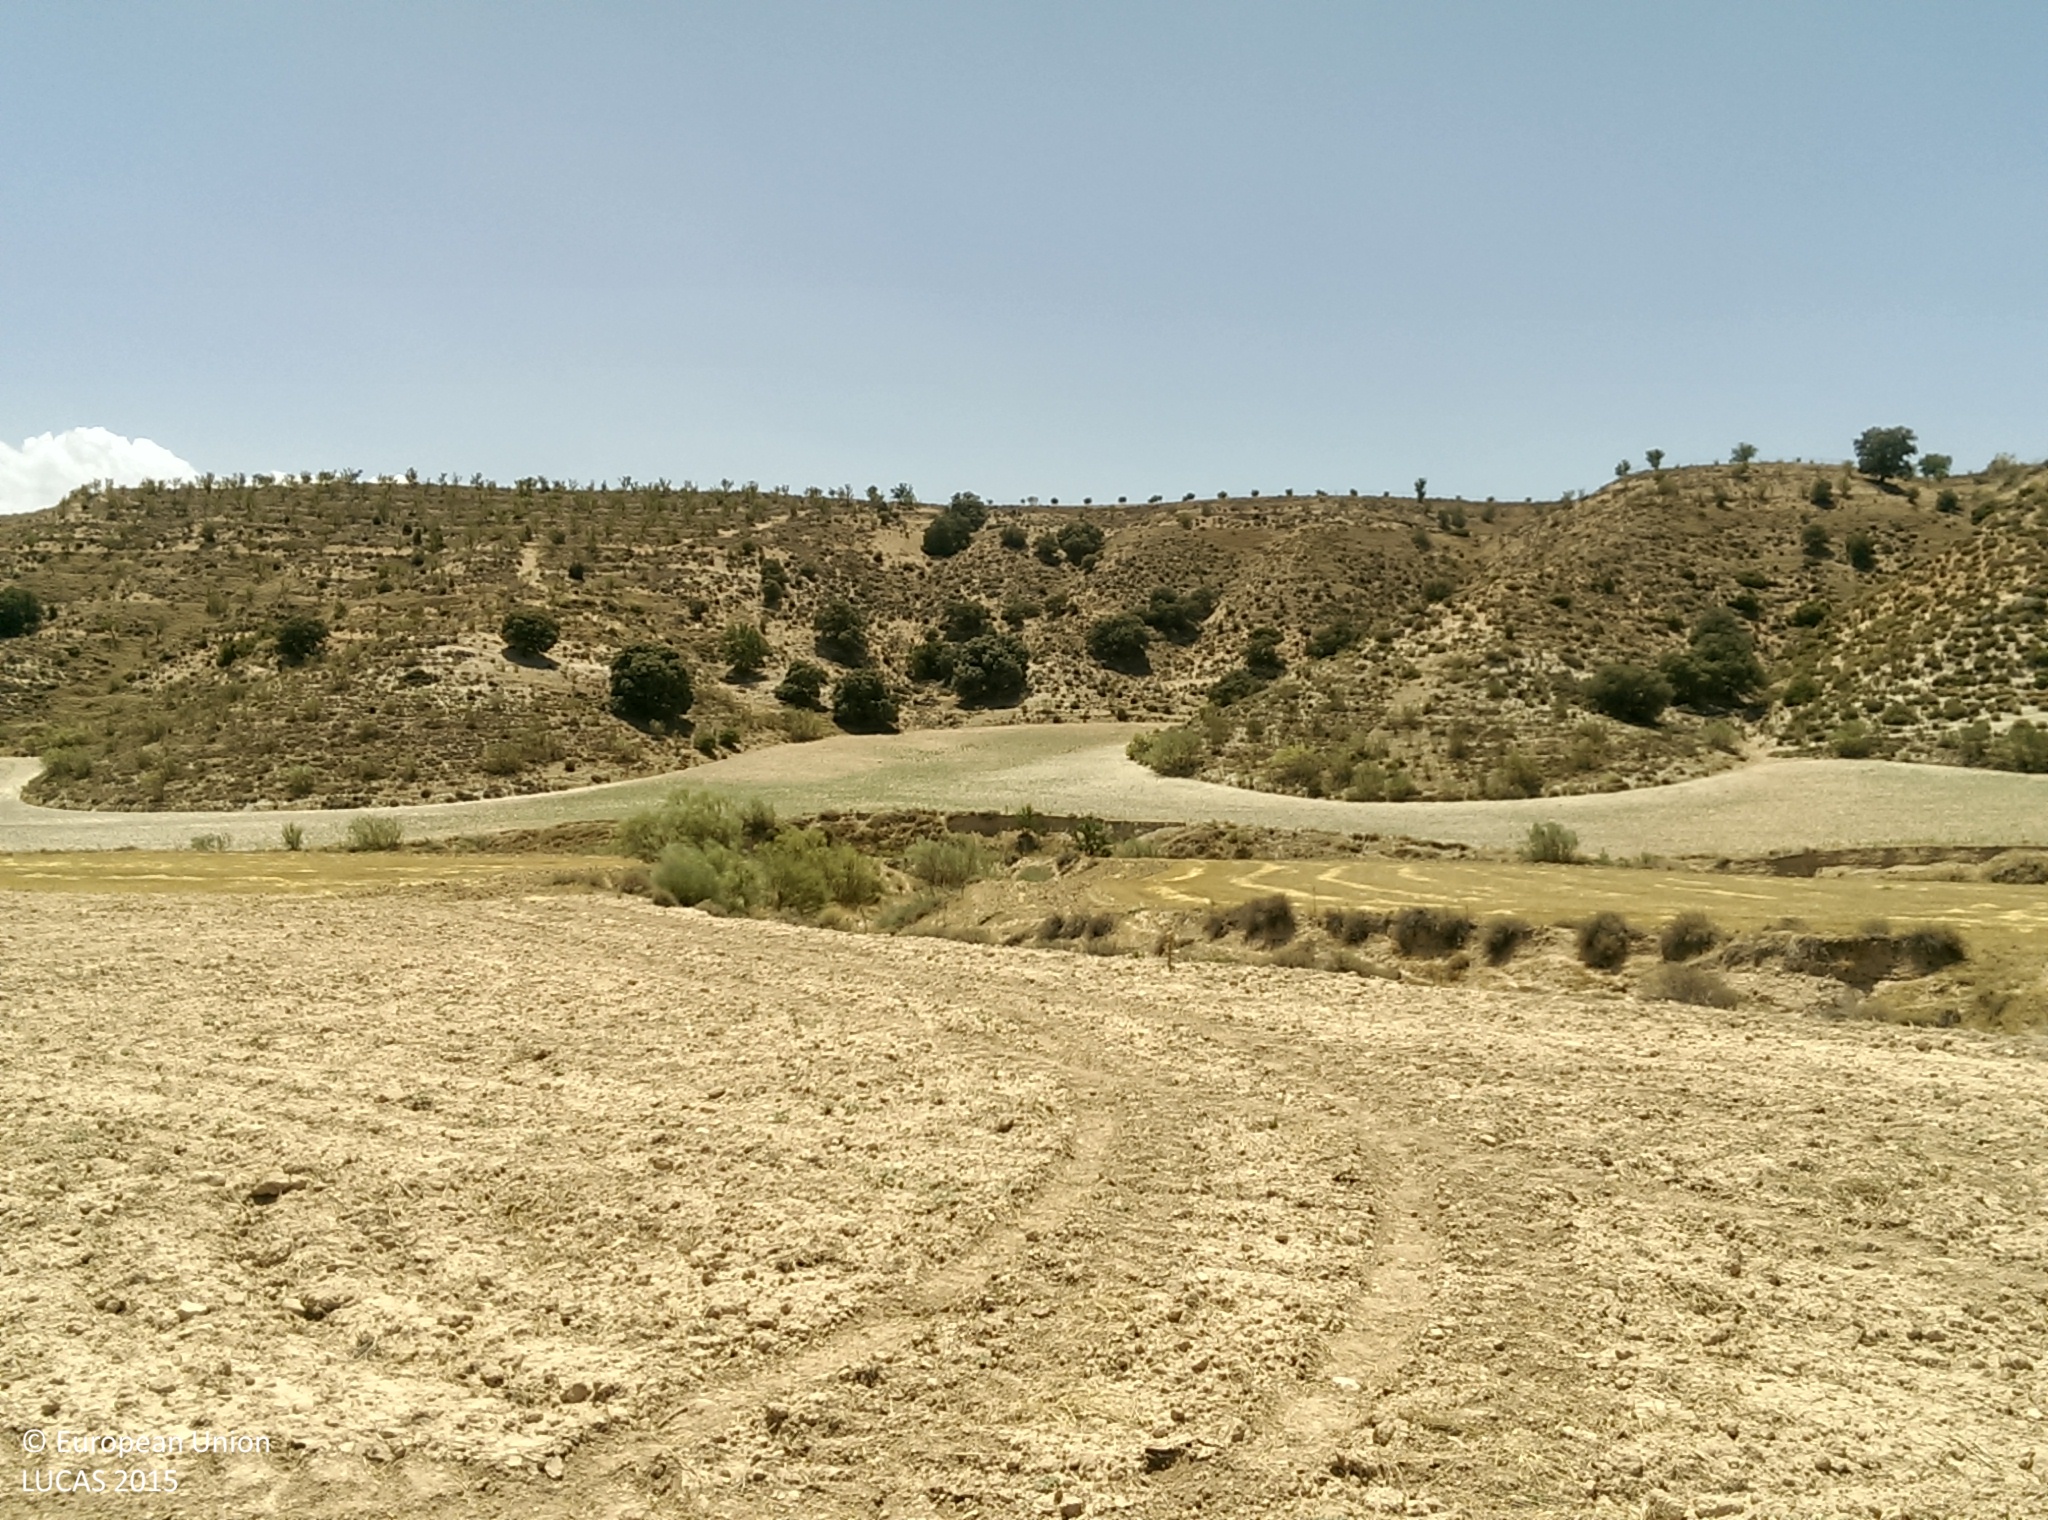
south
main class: Grassland
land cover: Grassland with sparse tree/shrub cover
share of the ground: 50 - 75 %
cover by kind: herbaceous plants 75 %, unconsolidated bare surface 15 %, broadleaved forest trees 5 %, shrubs 5 %
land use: Agriculture (excluding fallow land and kitchen gardens)
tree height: < 5 m
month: July
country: ES
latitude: 37.4401
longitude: -3.2480
